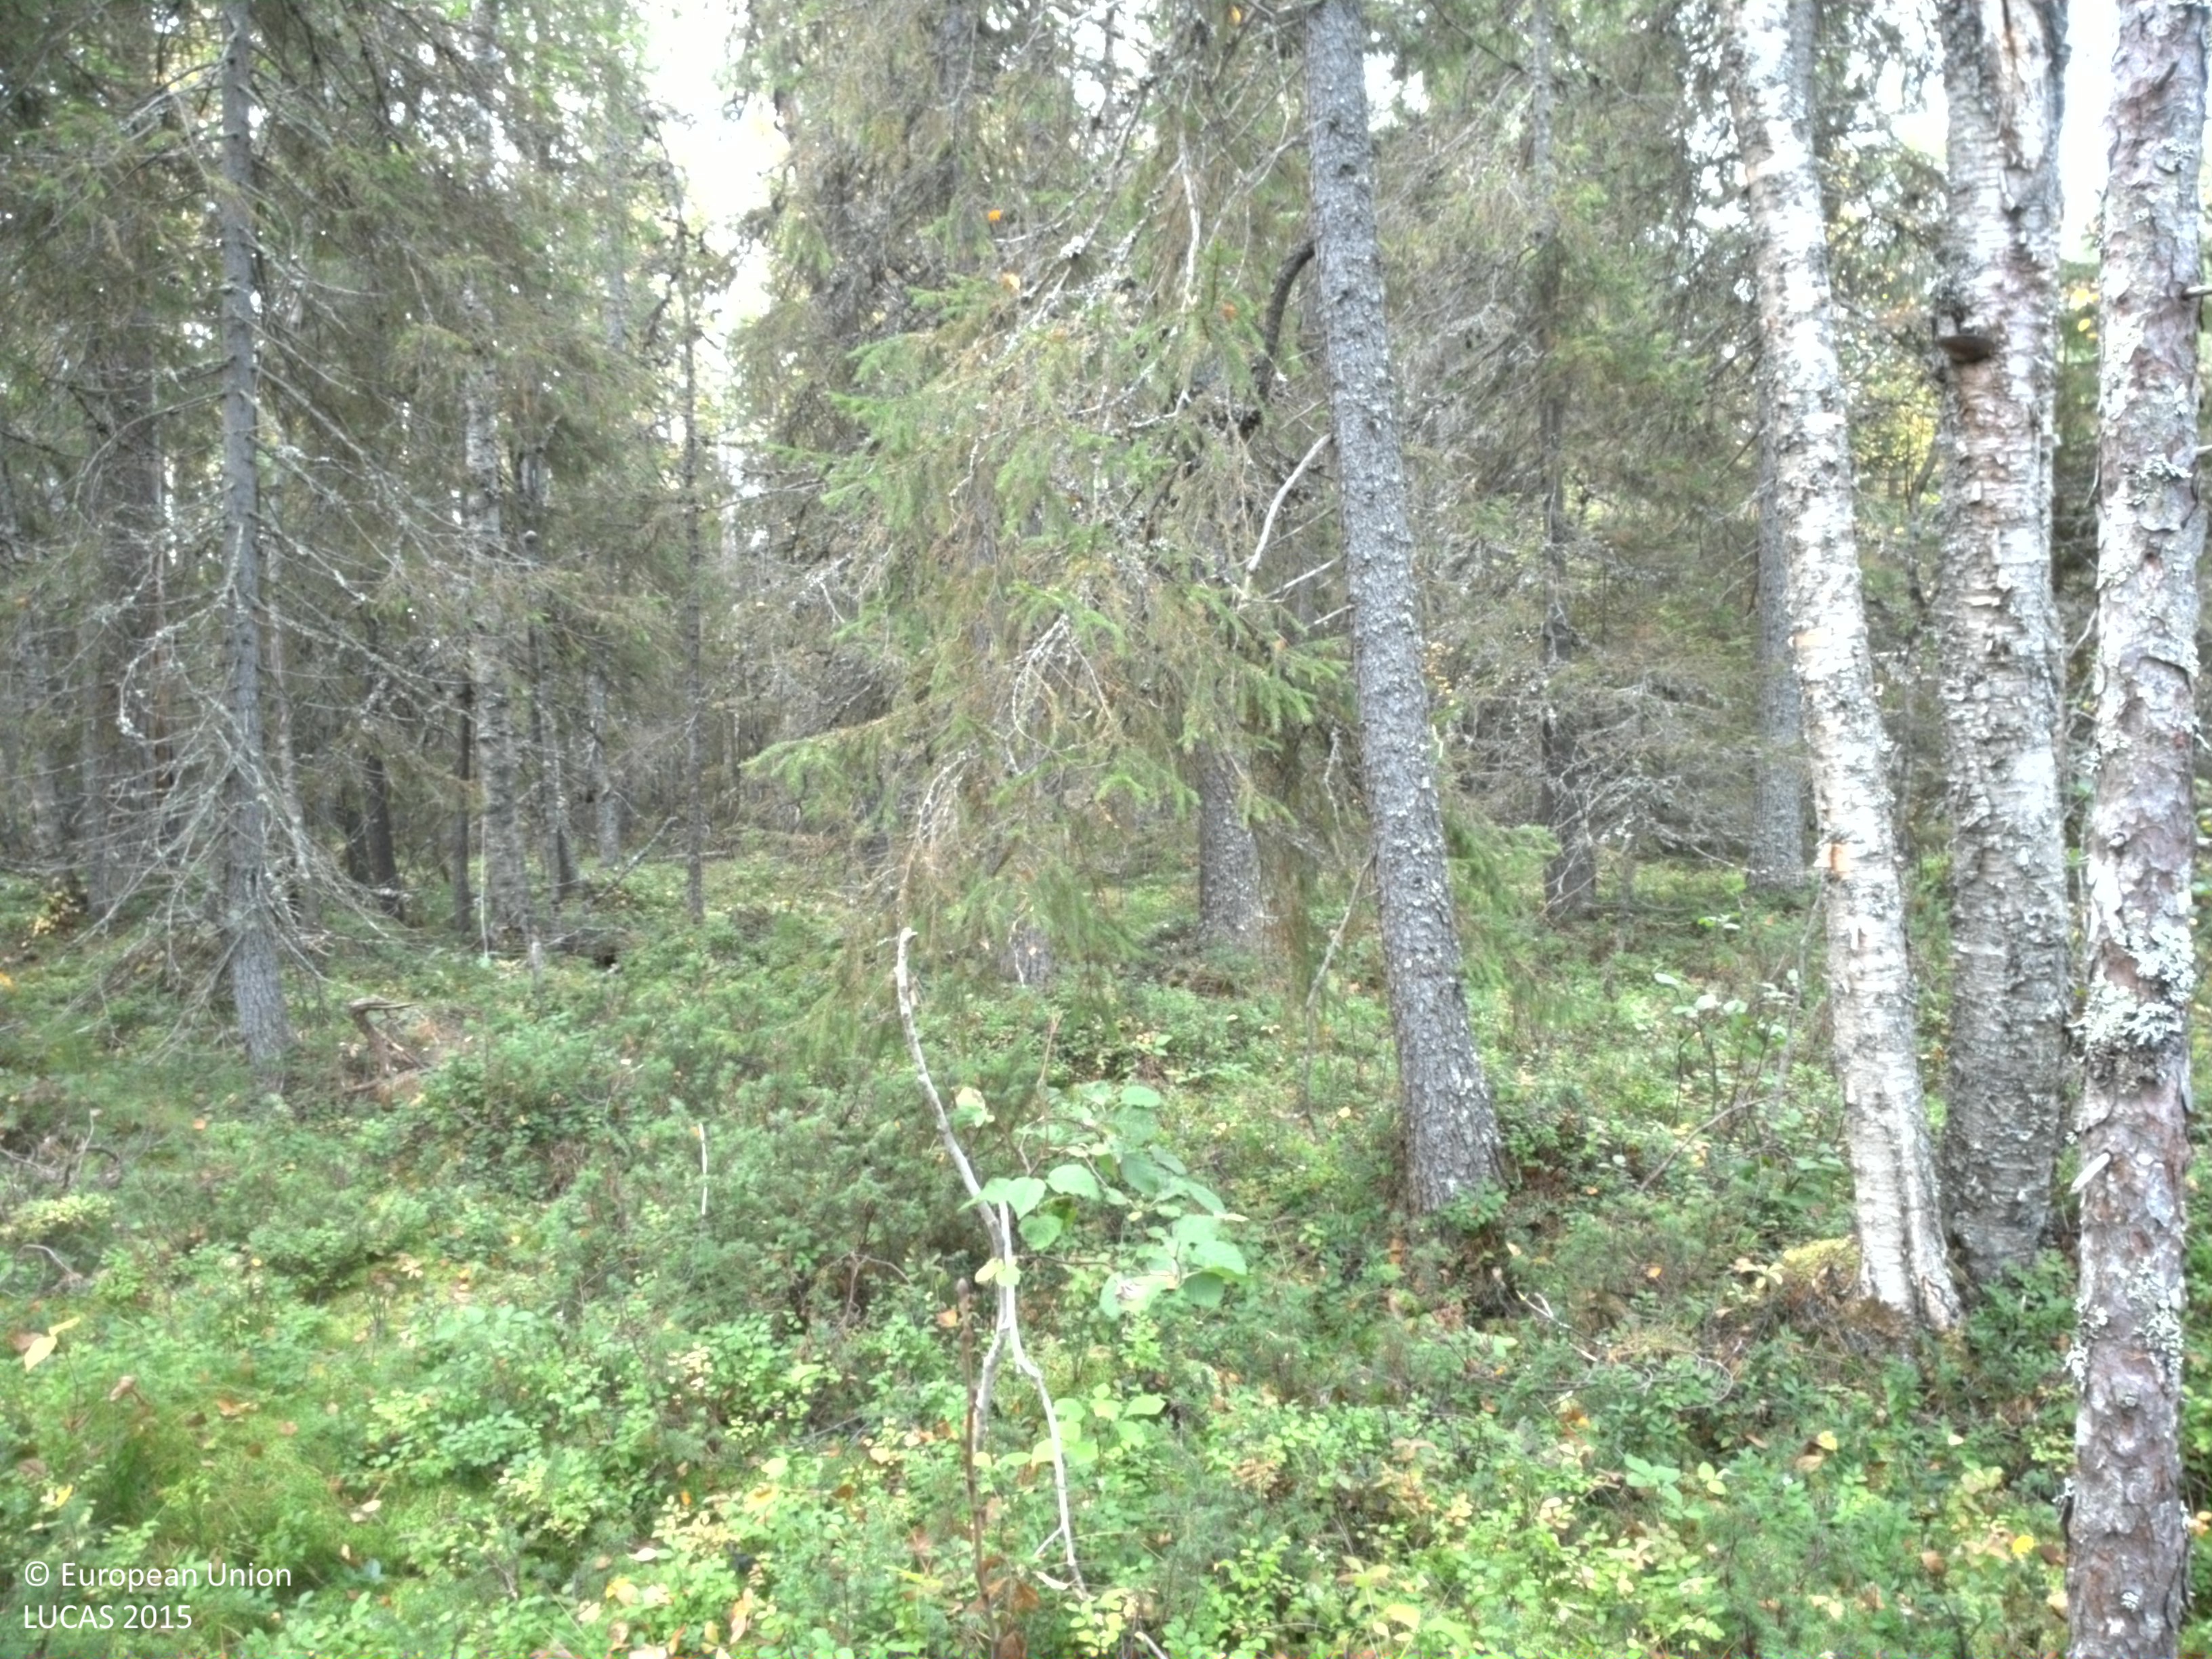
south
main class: Woodland
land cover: Pine dominated mixed woodland
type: boreal forest
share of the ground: 25 - 50 %
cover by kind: shrubs 45 %, coniferous forest trees 30 %, broadleaved forest trees 15 %, lichens and mosses 10 %
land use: Forestry
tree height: > 5 m
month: September
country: SE
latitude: 65.5328
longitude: 22.0316
